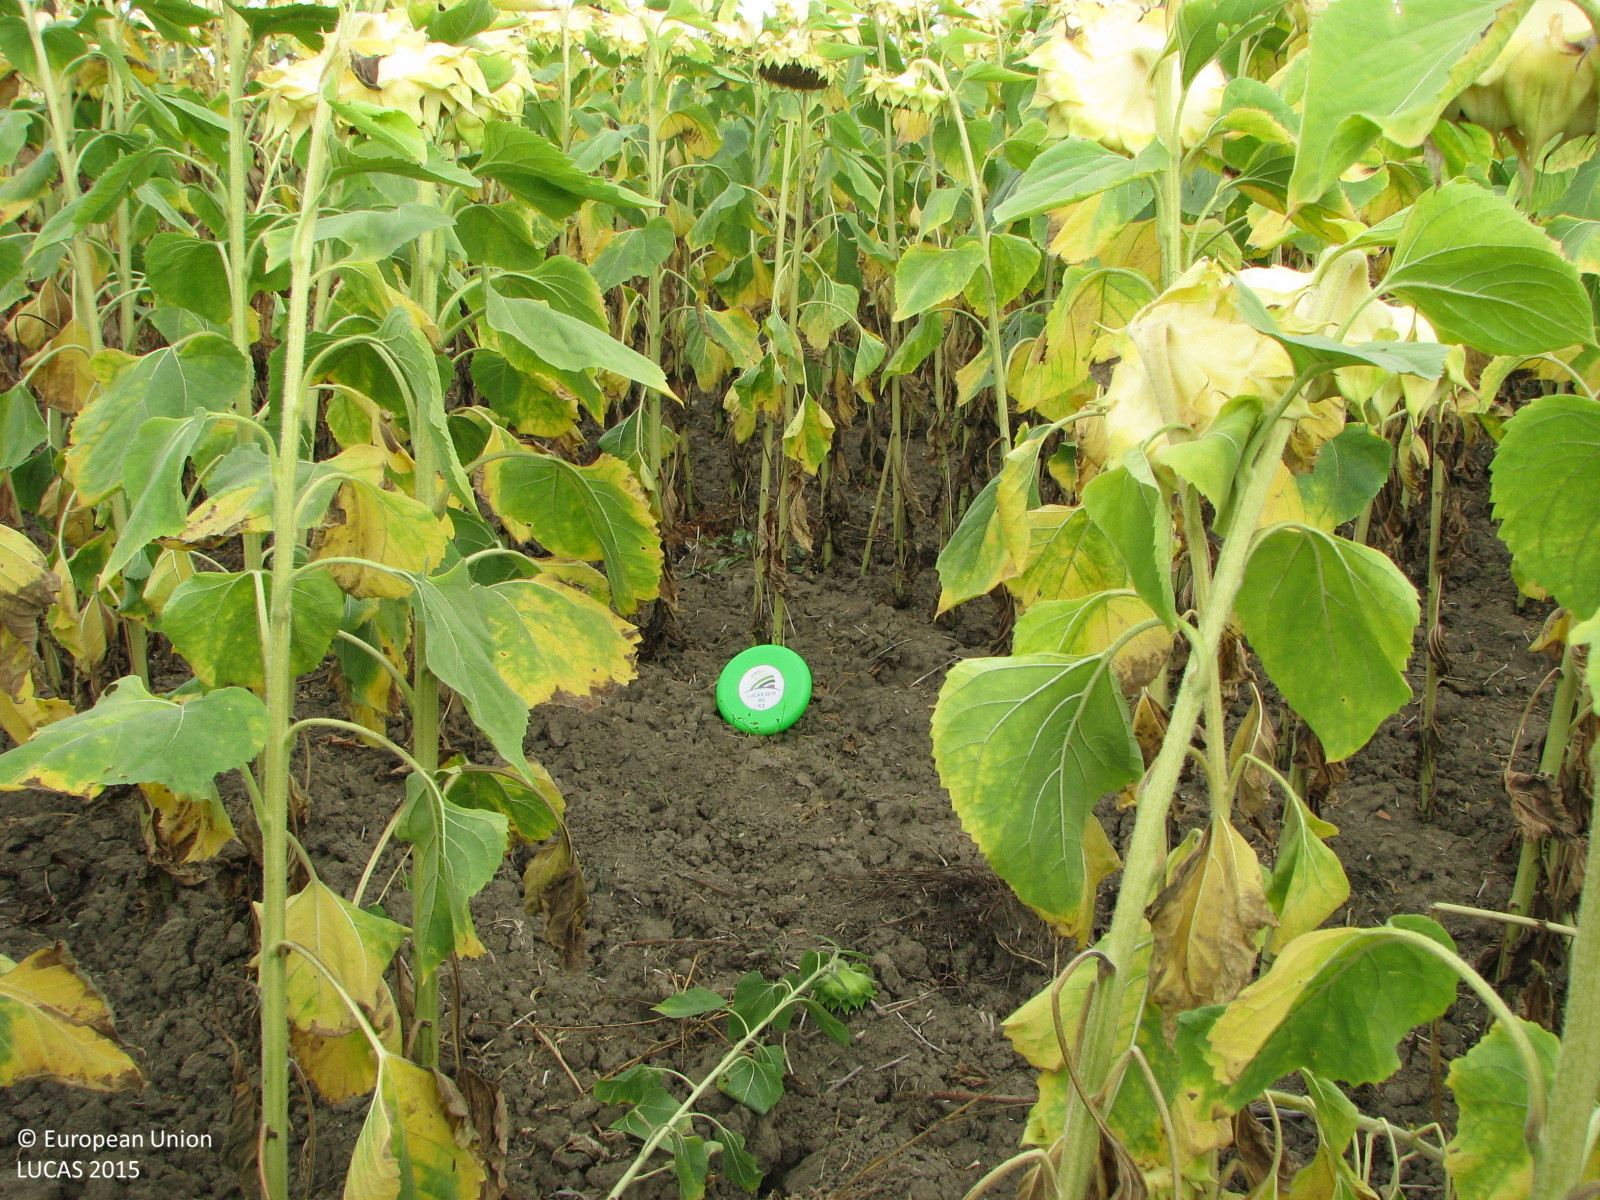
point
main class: Cropland
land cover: Sunflower
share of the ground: > 75 %
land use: Agriculture (excluding fallow land and kitchen gardens)
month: August
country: BG
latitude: 42.4457
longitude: 26.5175
